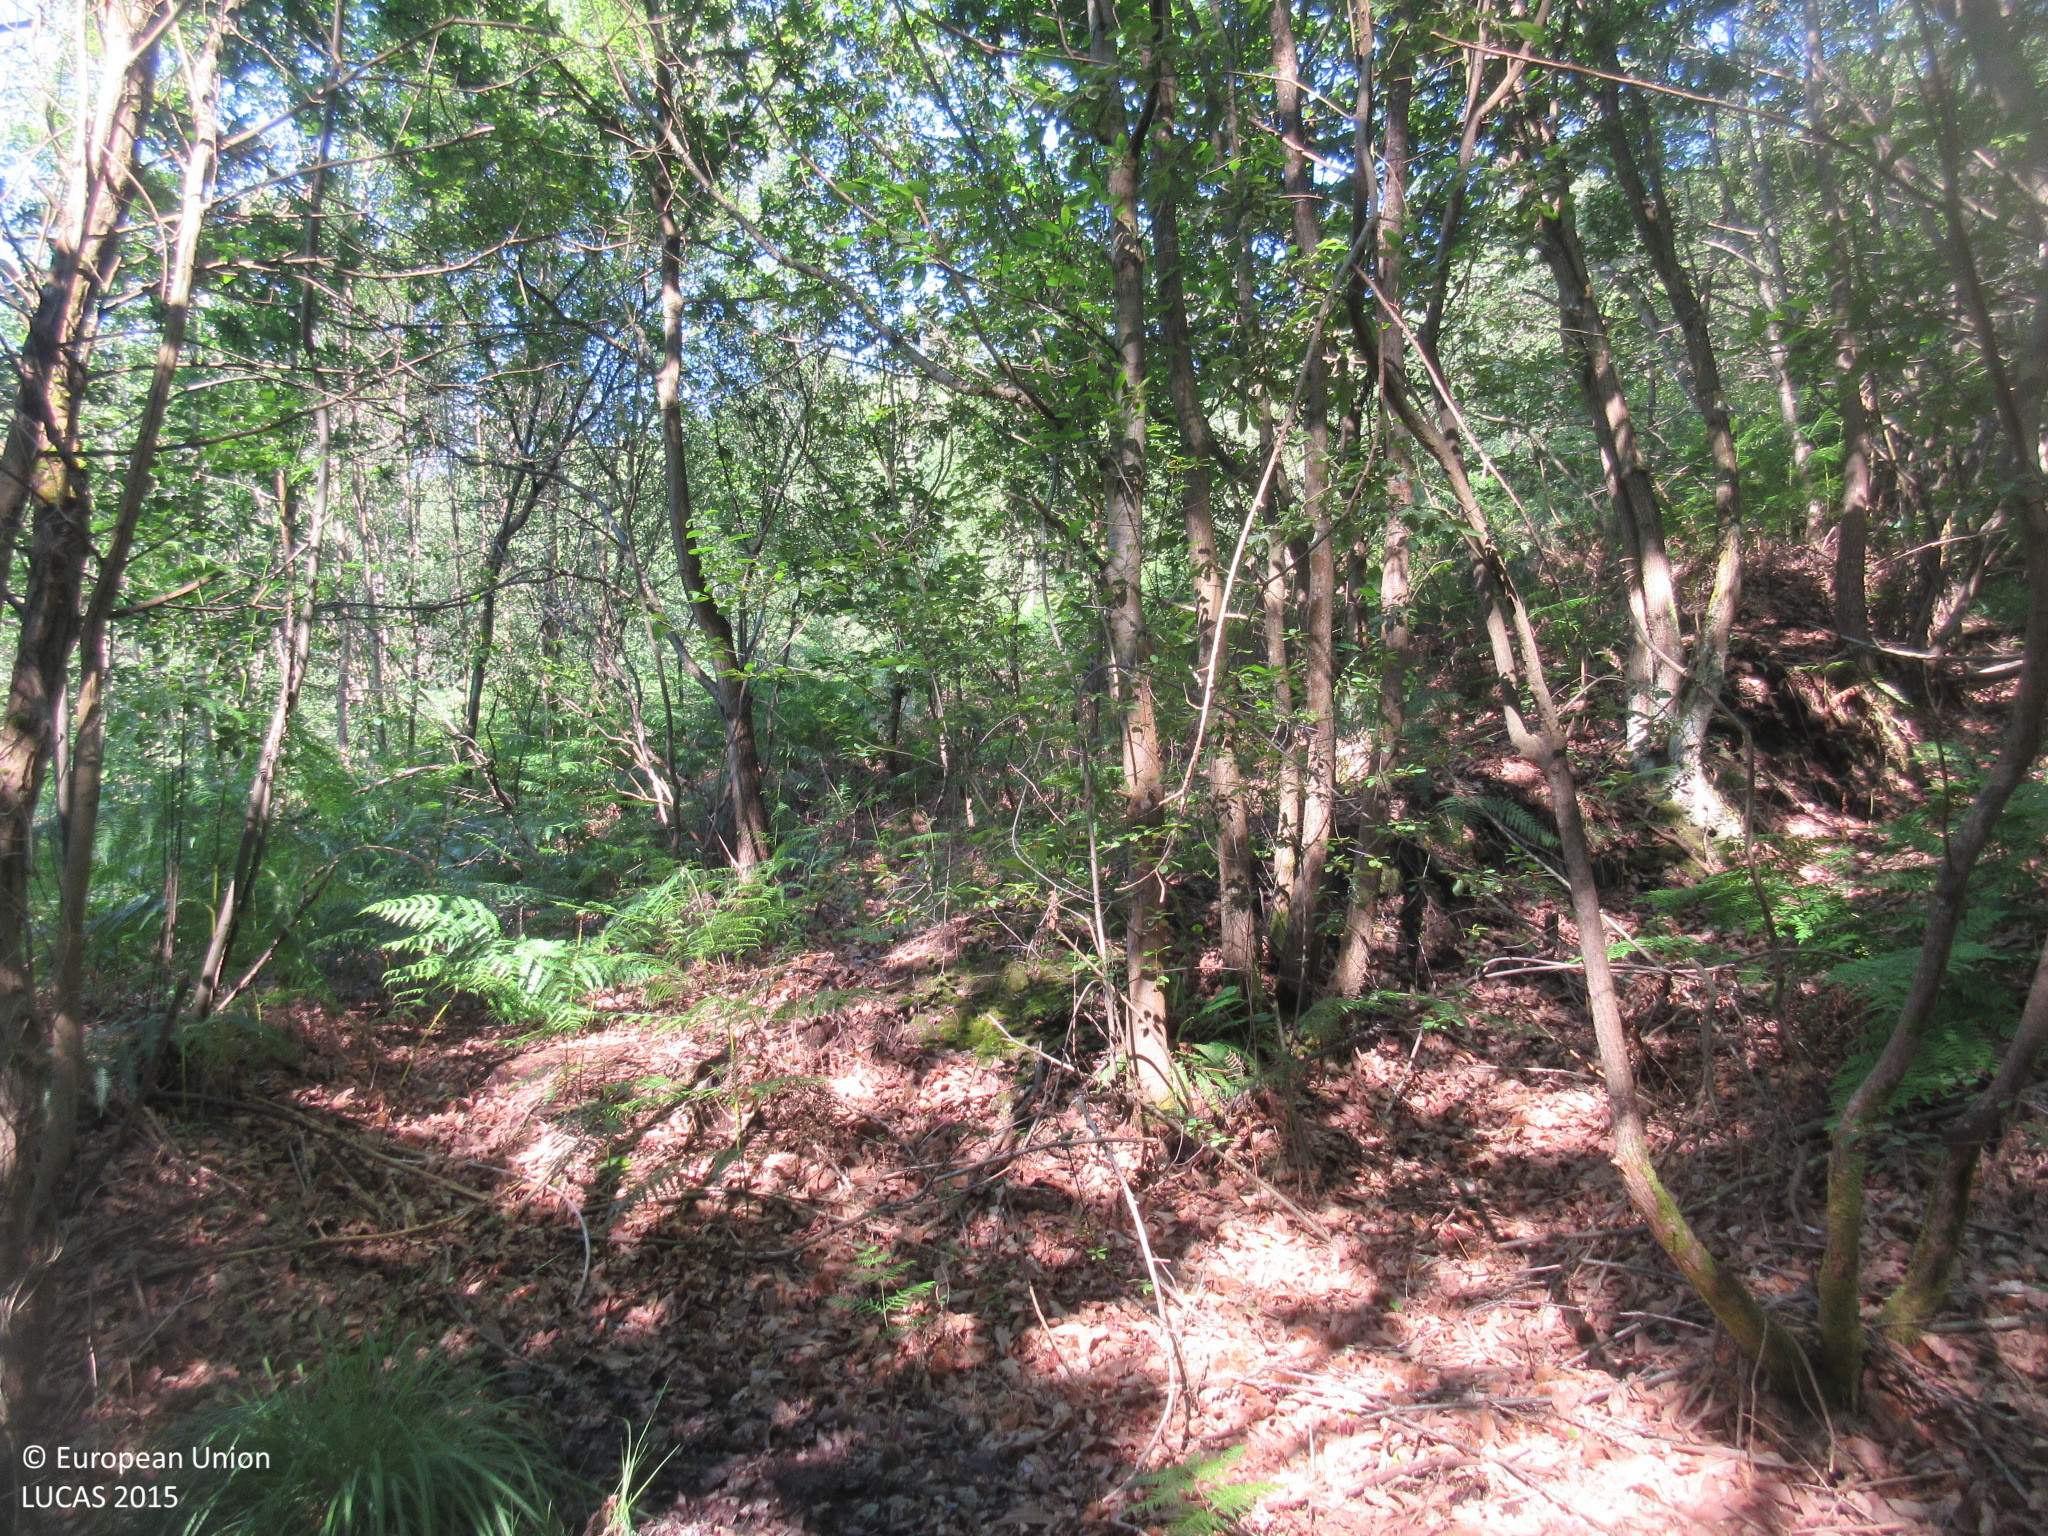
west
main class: Woodland
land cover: Broadleaved woodland
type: thermophilous deciduous forest
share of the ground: > 75 %
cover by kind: broadleaved forest trees 100 %
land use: Forestry
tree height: > 5 m
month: June
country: ES
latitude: 43.3885
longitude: -6.0292
